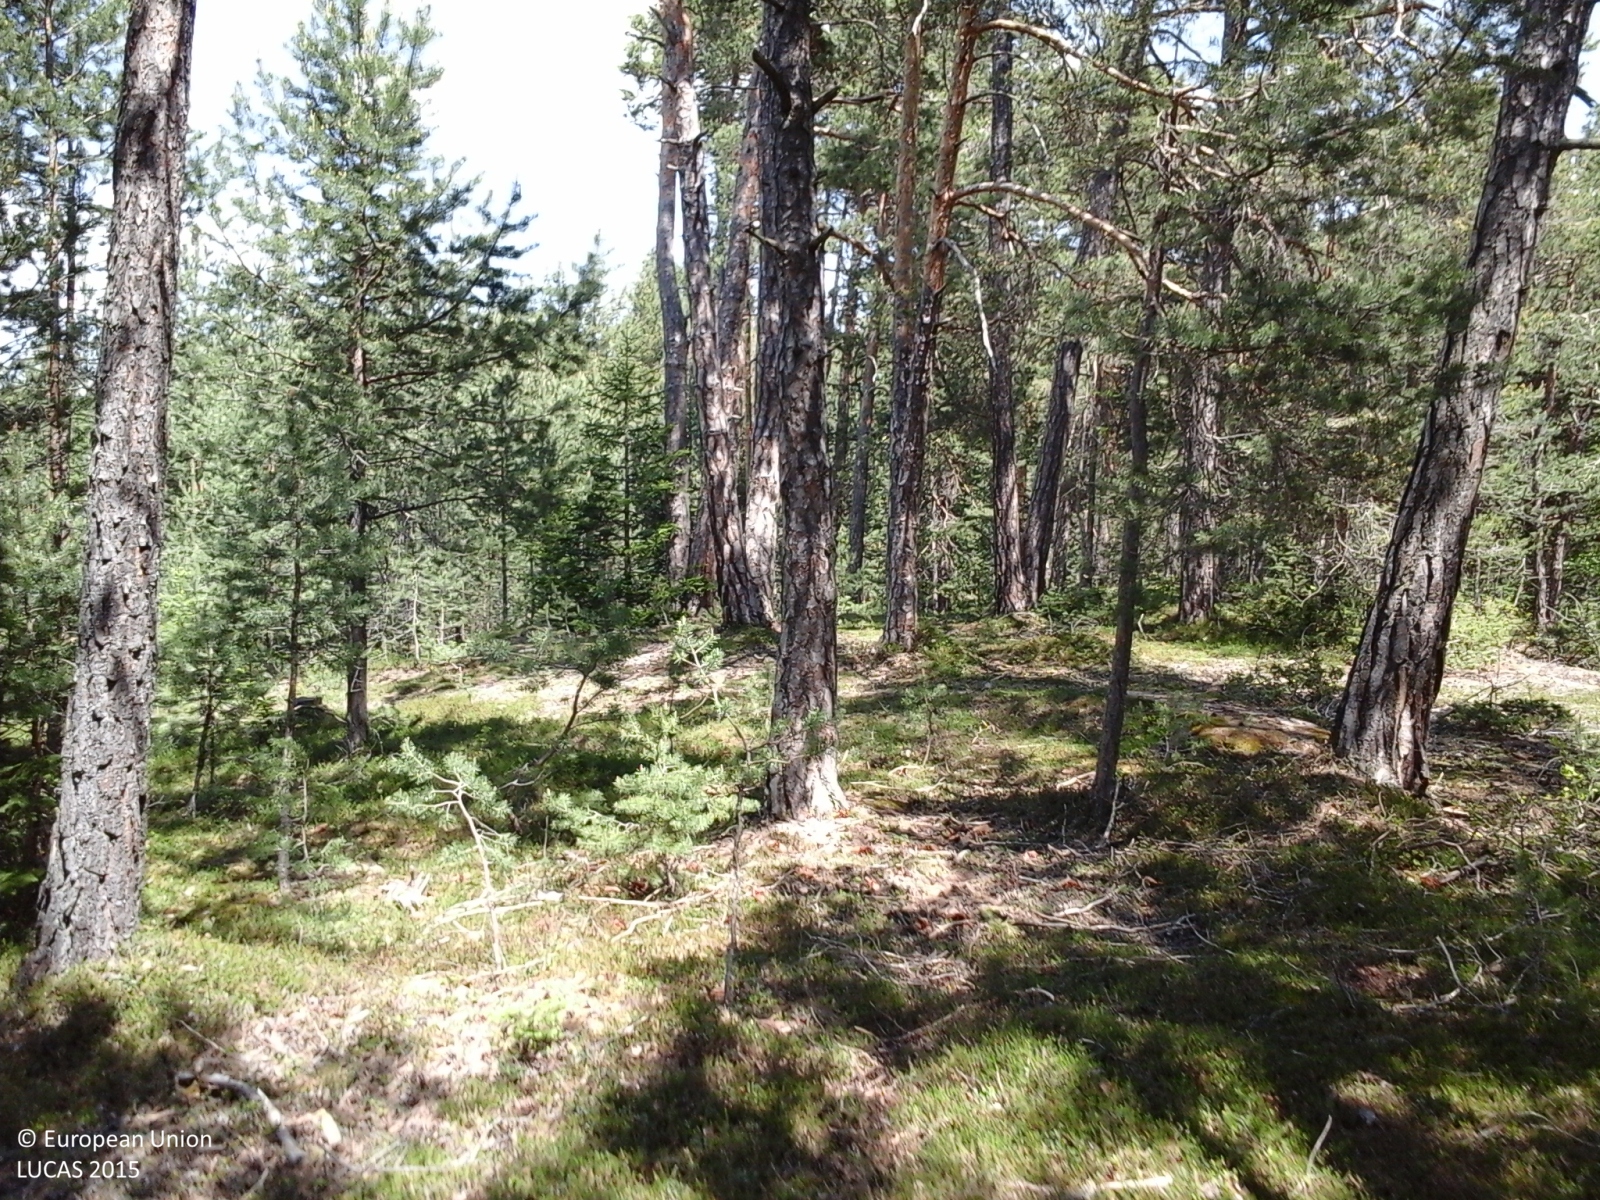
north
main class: Woodland
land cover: Pine dominated coniferous woodland
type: alpine coniferous forest
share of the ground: > 75 %
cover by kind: coniferous forest trees 100 %
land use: Forestry
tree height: > 5 m
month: May
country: IT
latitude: 46.5738
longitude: 11.5770
